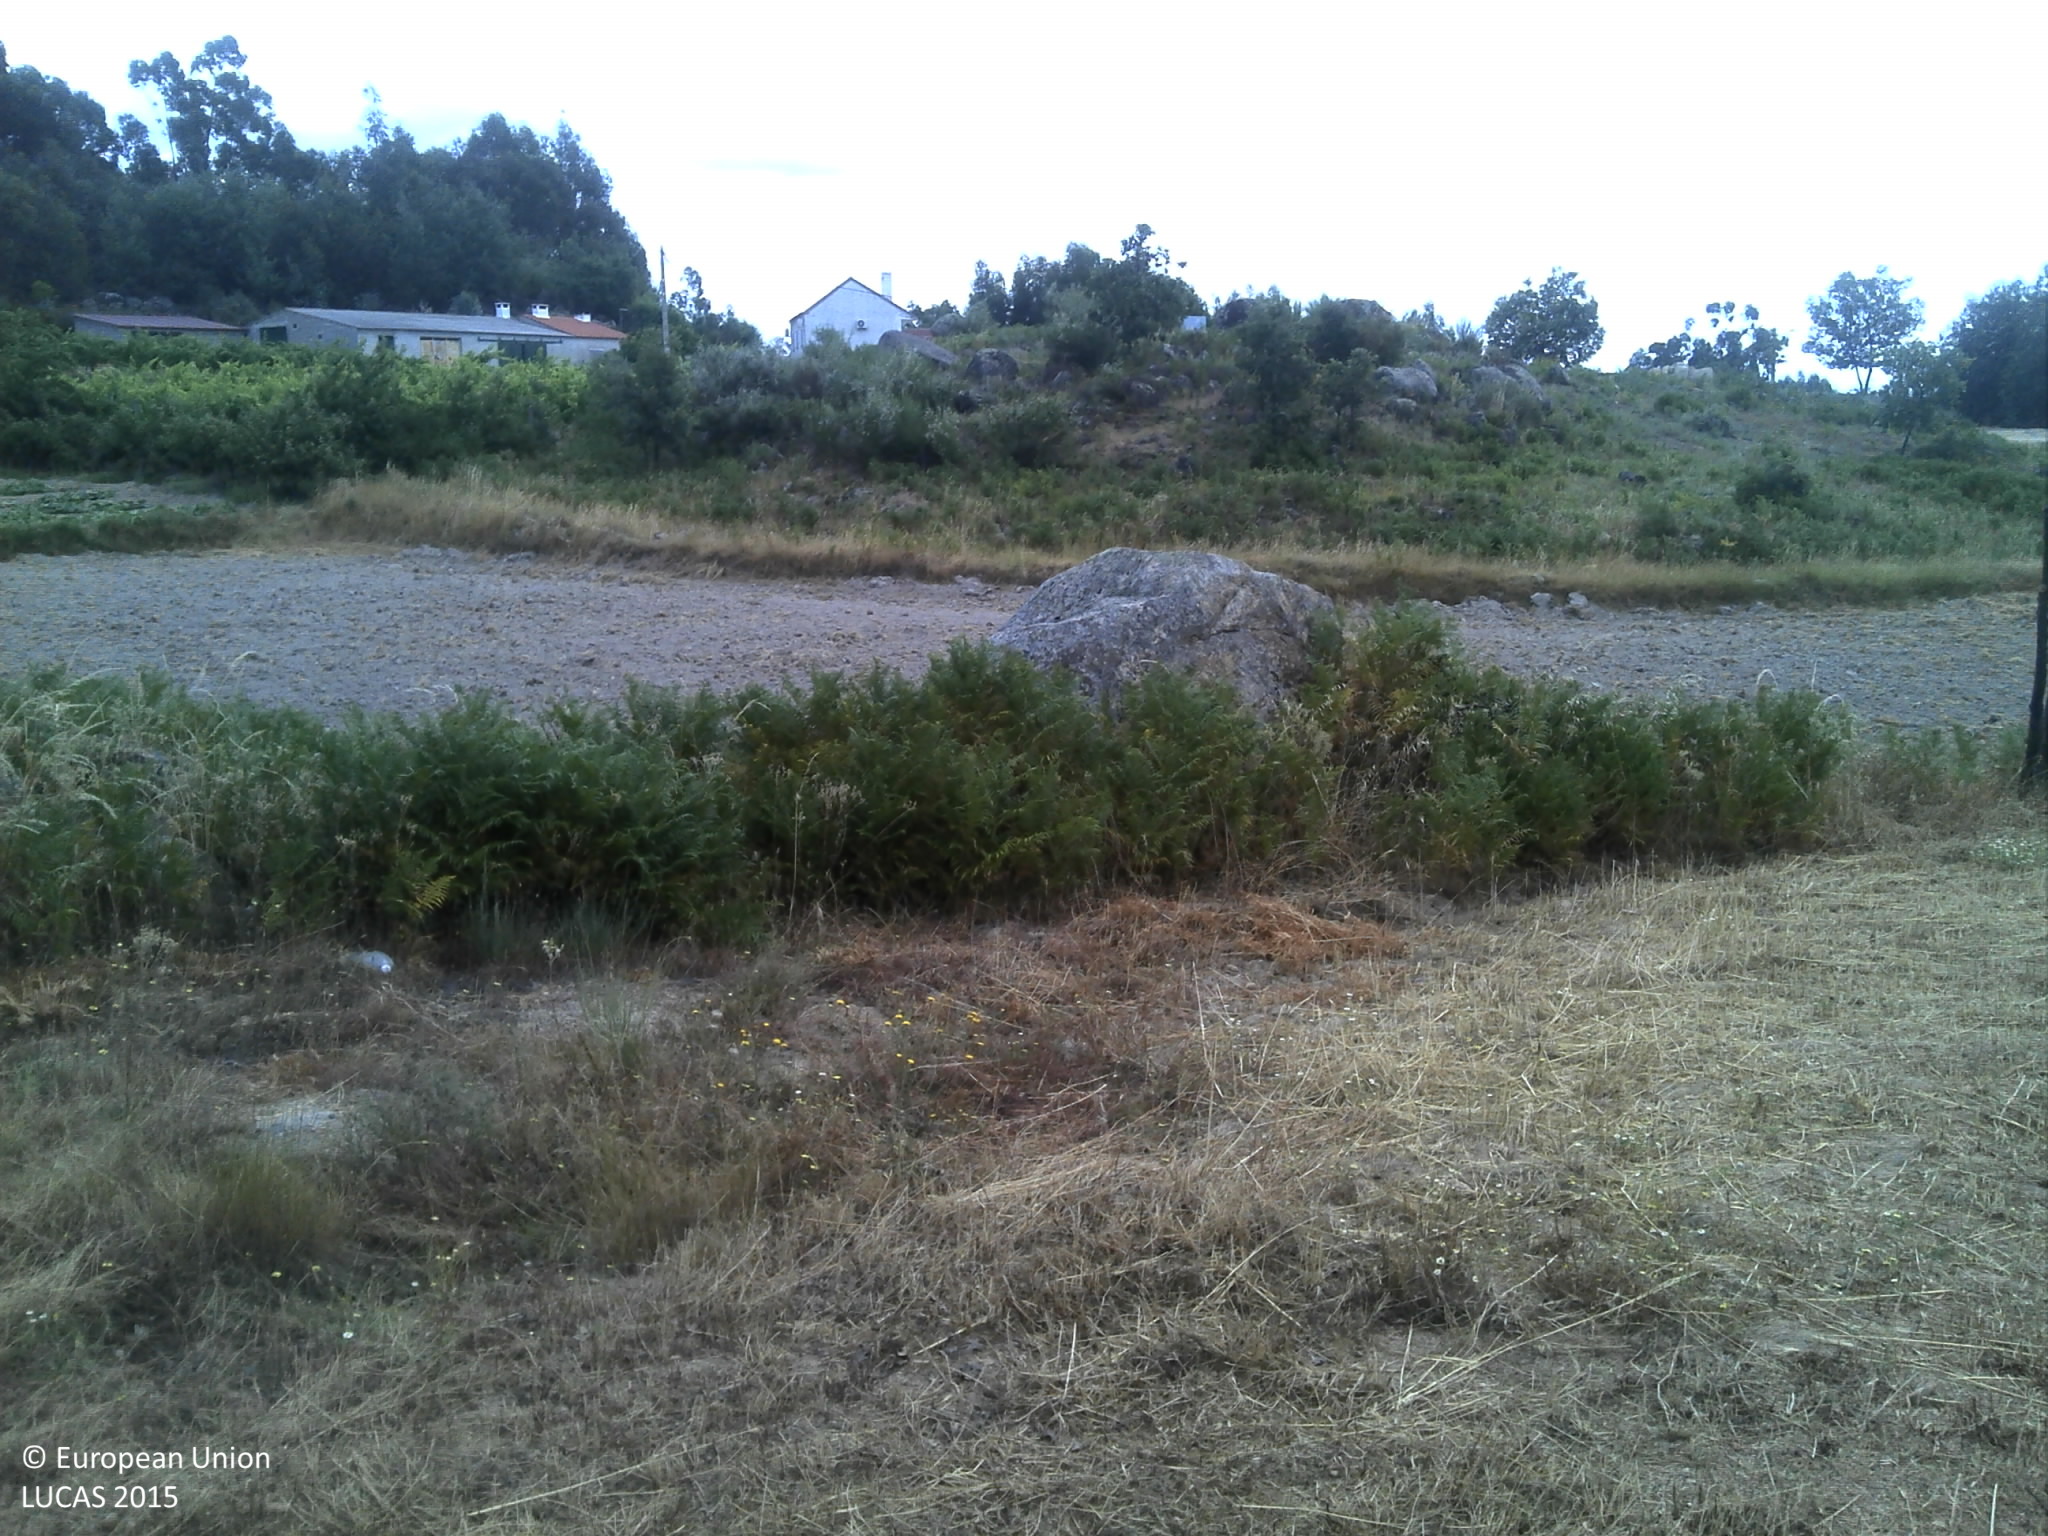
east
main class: Cropland
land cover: Olive groves
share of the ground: 10 - 25 %
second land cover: Spontaneously vegetated surfaces
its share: < 10 %
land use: Agriculture (excluding fallow land and kitchen gardens)
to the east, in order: Olive groves; Spontaneously vegetated surfaces; Grass margins; Rock outcrops; Other bare soil; Grass margins; Tracks; Grassland without tree/shrub cover; Tracks; Grassland without tree/shrub cover; Rock outcrops; Dry stone walls; Paved roads, cycling and walking lanes; Electric lines; Dry stone walls; Ditches and canals; Olive groves; Vineyards; Apple fruit; Spontaneously vegetated surfaces; Dry stone walls; Olive groves
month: June
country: PT
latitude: 40.1348
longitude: -7.3175
